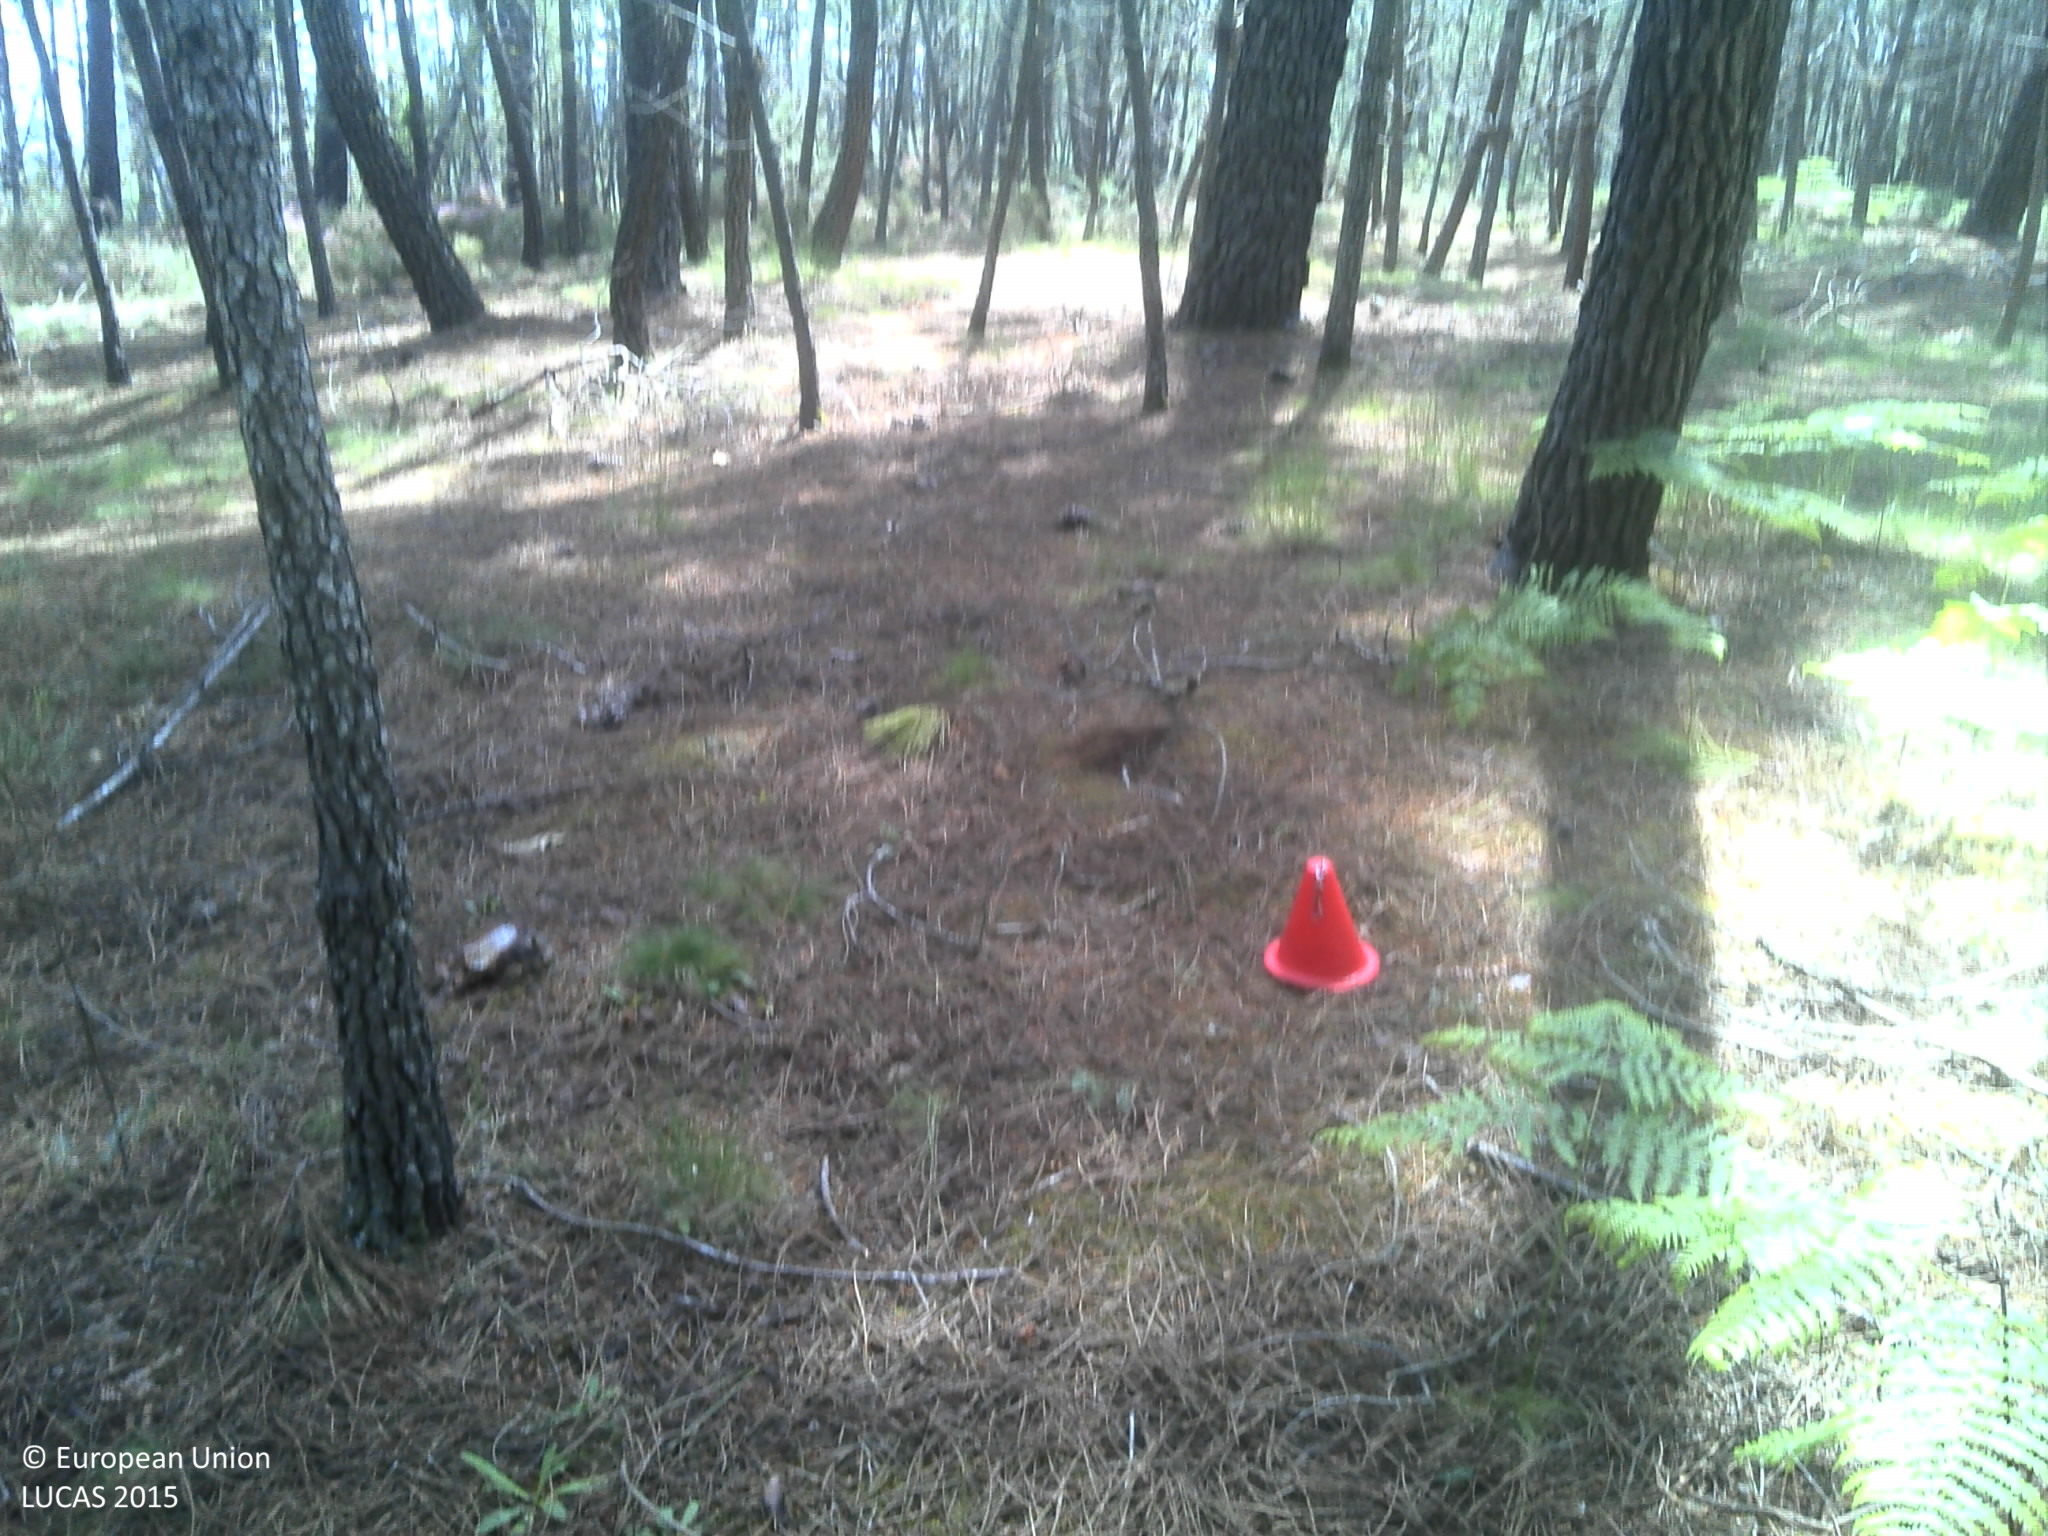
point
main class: Woodland
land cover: Pine dominated coniferous woodland
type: coniferous forest of the mediterranean region
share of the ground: > 75 %
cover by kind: coniferous forest trees 90 %, shrubs 10 %
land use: Forestry
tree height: > 5 m
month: May
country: PT
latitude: 40.6907
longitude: -7.8132
